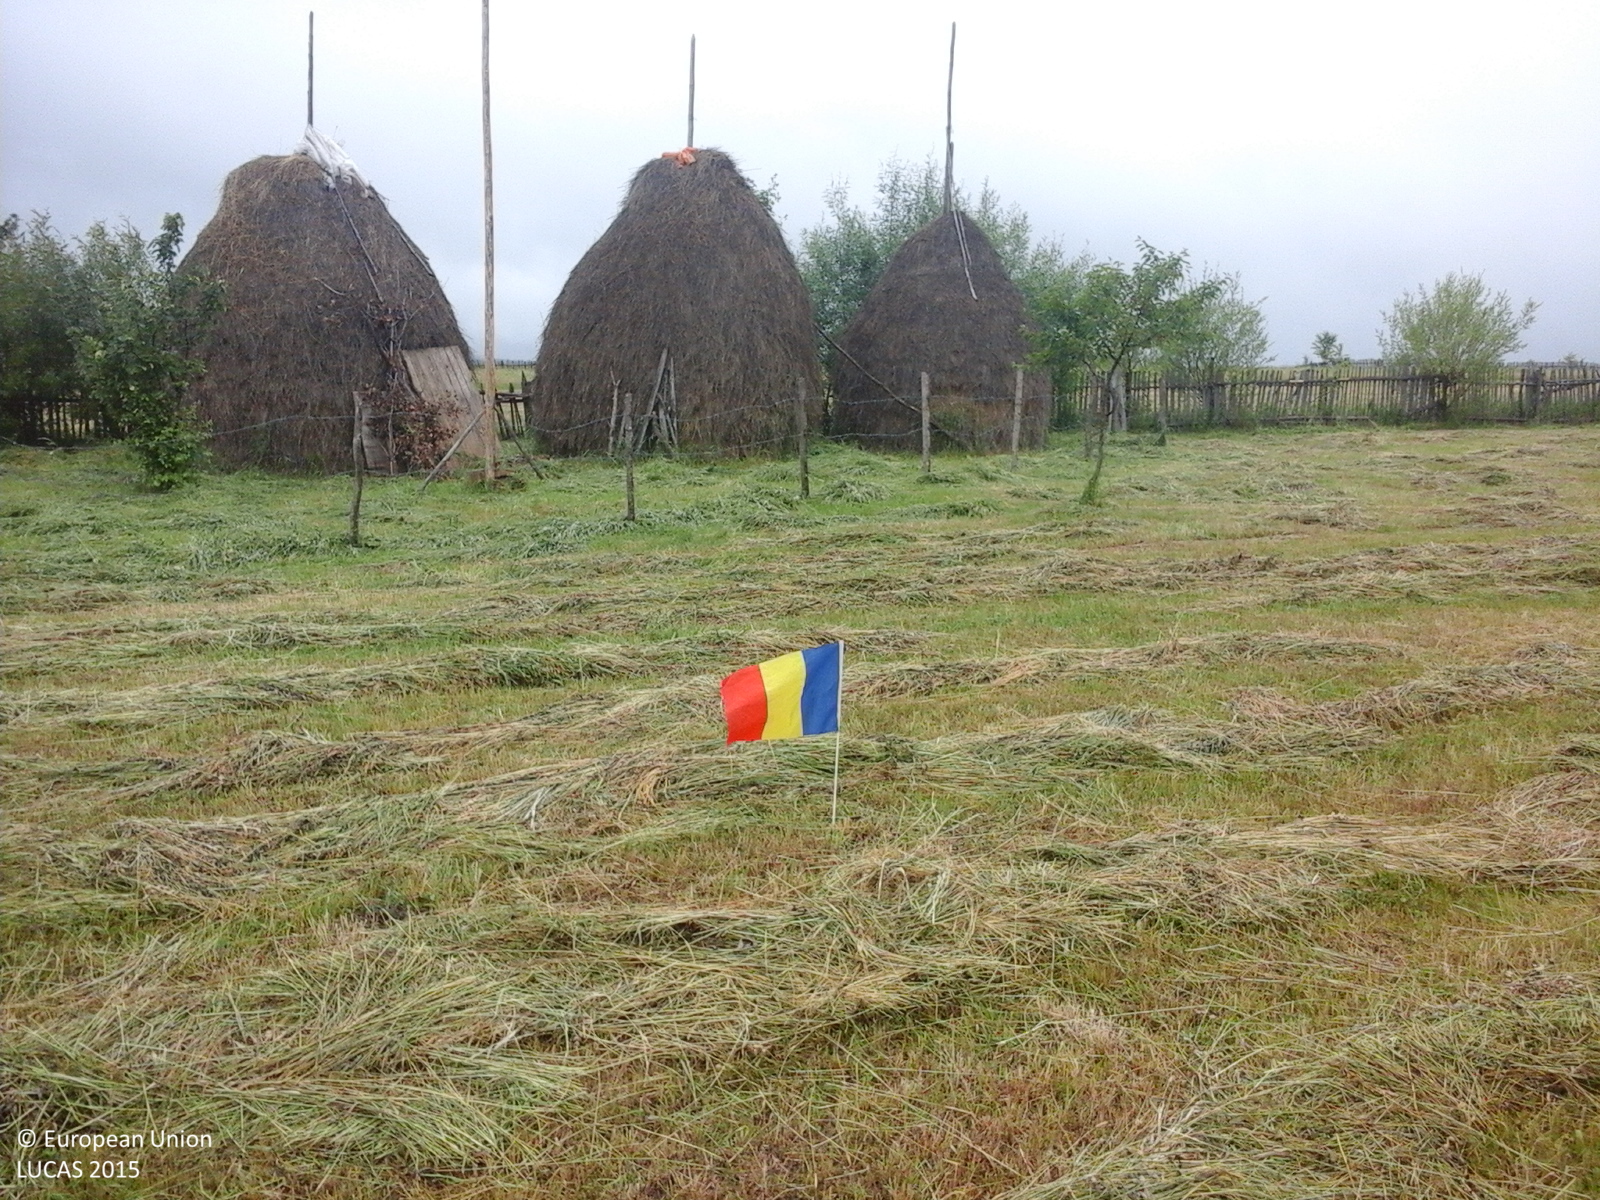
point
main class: Grassland
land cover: Grassland without tree/shrub cover
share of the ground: > 75 %
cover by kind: herbaceous plants 100 %
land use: Agriculture (excluding fallow land and kitchen gardens)
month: June
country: RO
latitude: 47.3175
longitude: 26.2610
